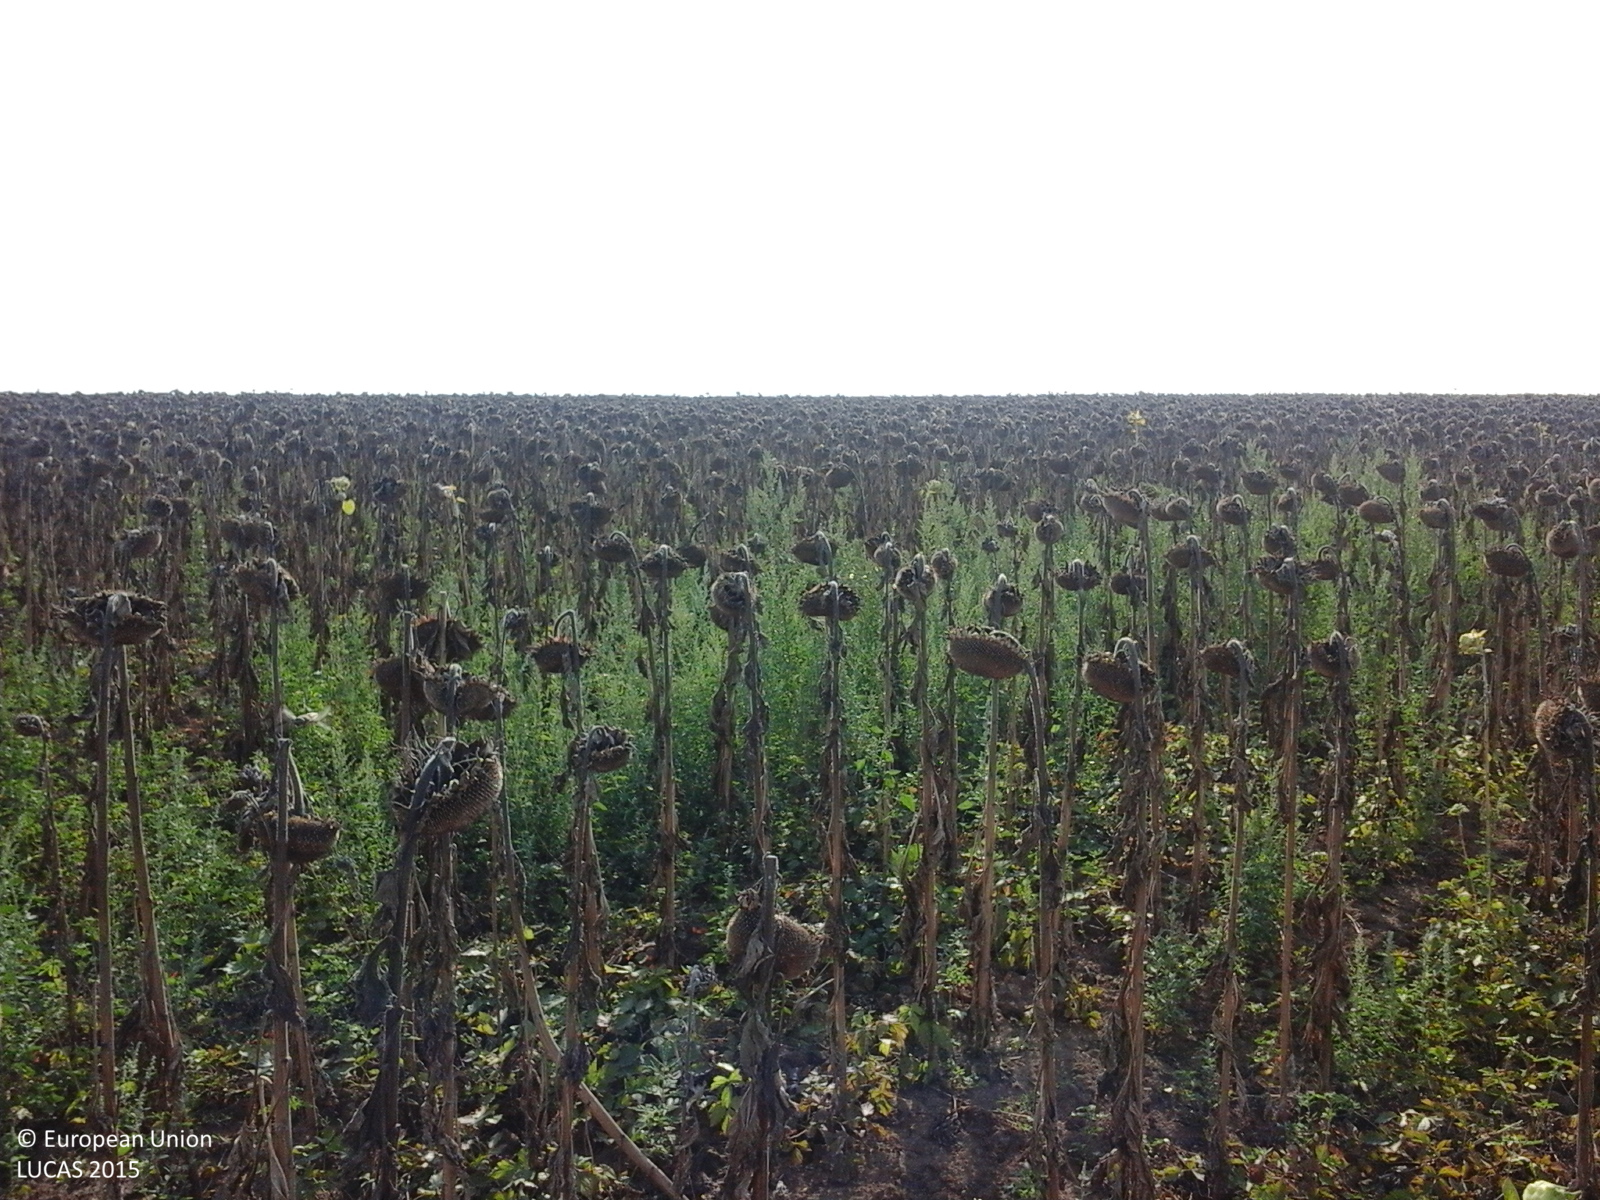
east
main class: Cropland
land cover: Sunflower
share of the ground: > 75 %
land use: Agriculture (excluding fallow land and kitchen gardens)
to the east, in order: Sunflower
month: August
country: RO
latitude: 46.0766
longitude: 21.4786
